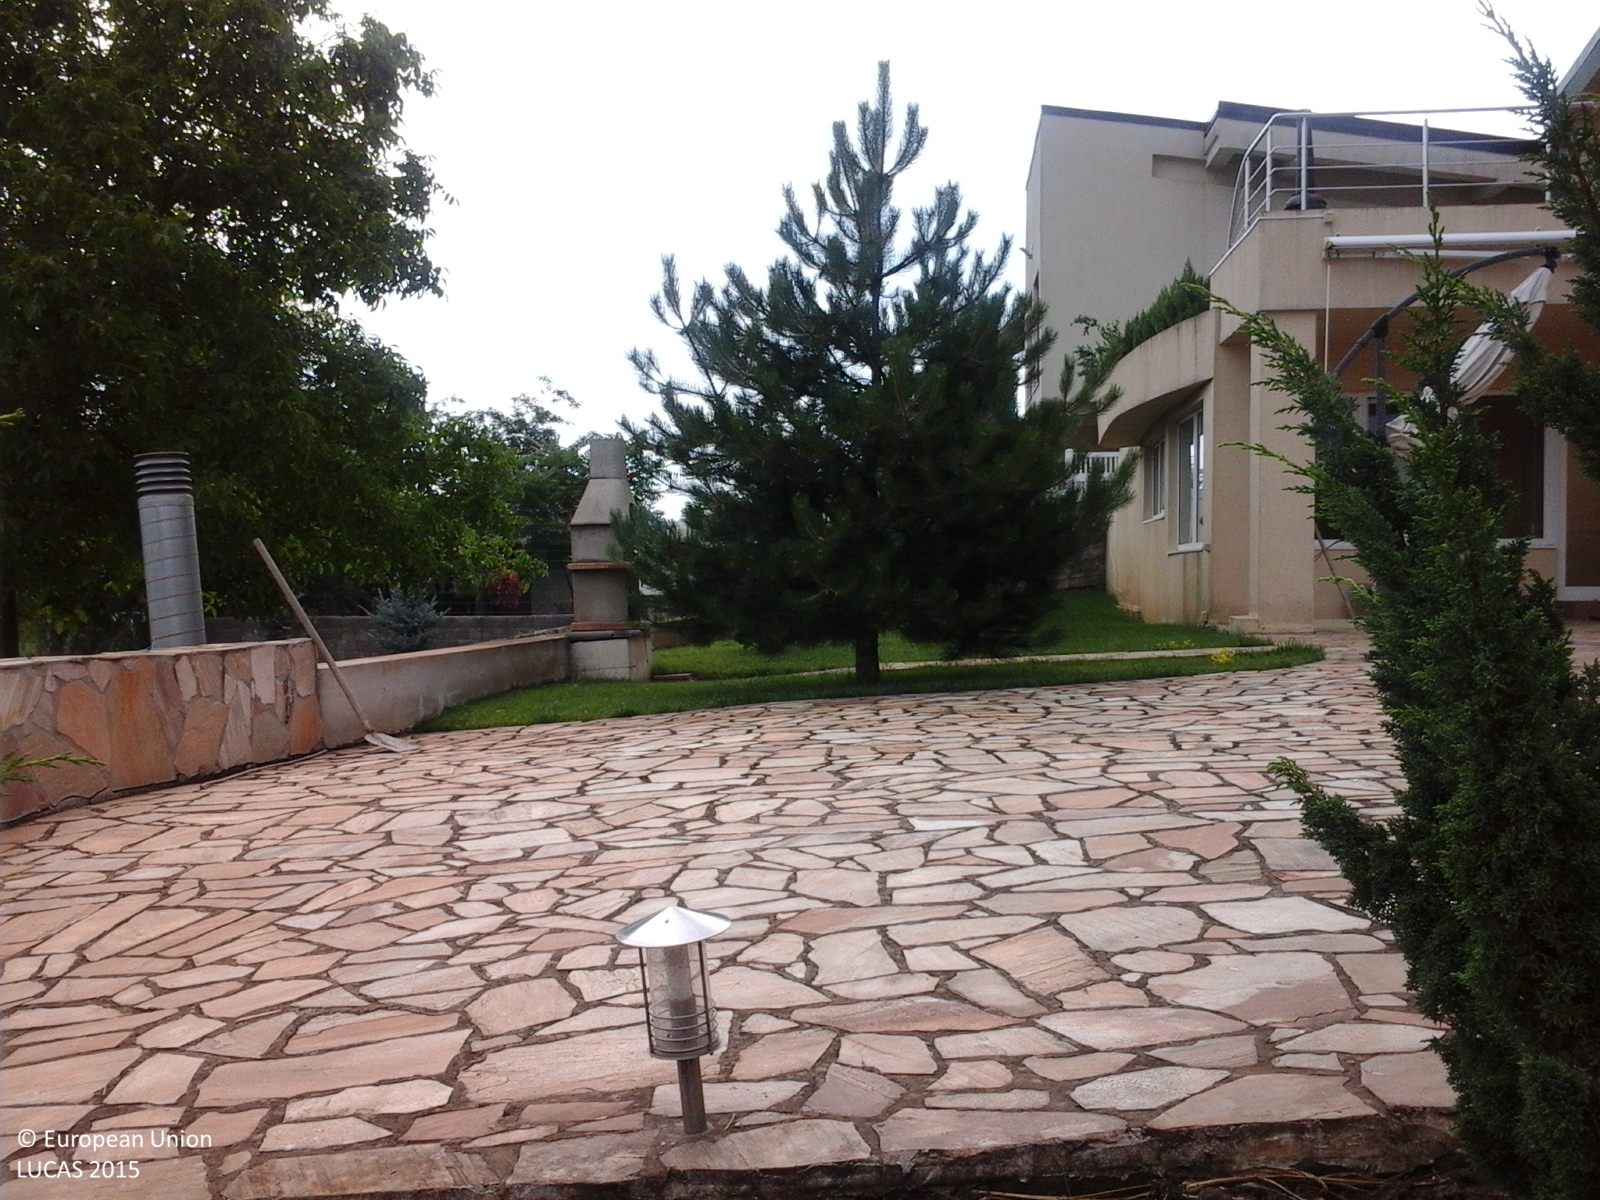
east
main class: Grassland
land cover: Grassland with sparse tree/shrub cover
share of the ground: > 75 %
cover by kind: herbaceous plants 95 %, coniferous forest trees 5 %
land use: Residential
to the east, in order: Grassland with sparse tree/shrub cover; Artificial constructions in urban areas; Grassland without tree/shrub cover; Broadleaved woodland; Inland fresh water bodies; Grass margins; Tracks; Fences; Grassland without tree/shrub cover
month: June
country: RO
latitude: 44.6020
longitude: 26.0172
